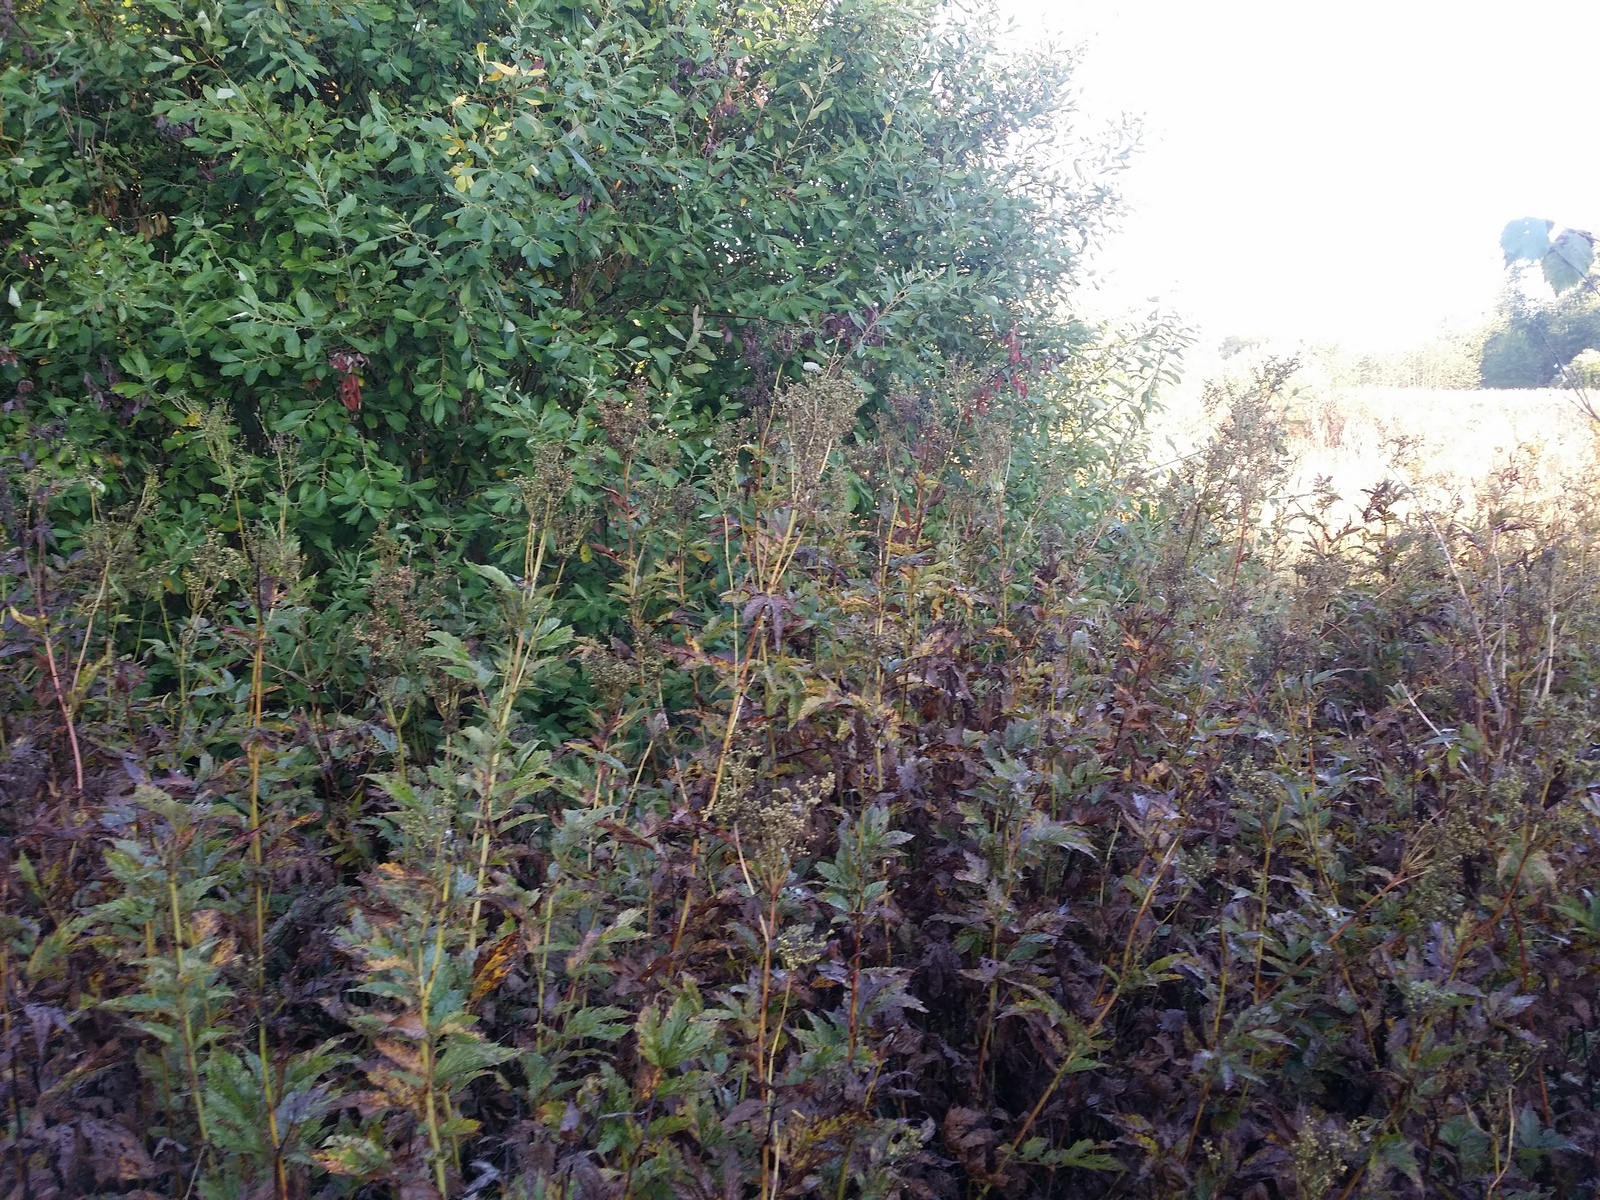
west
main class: Shrubland
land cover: Shrubland without tree cover
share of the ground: 25 - 50 %
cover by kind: herbaceous plants 65 %, shrubs 35 %
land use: Semi-natural and natural areas not in use
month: September
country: LV
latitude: 57.0645
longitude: 27.1680
